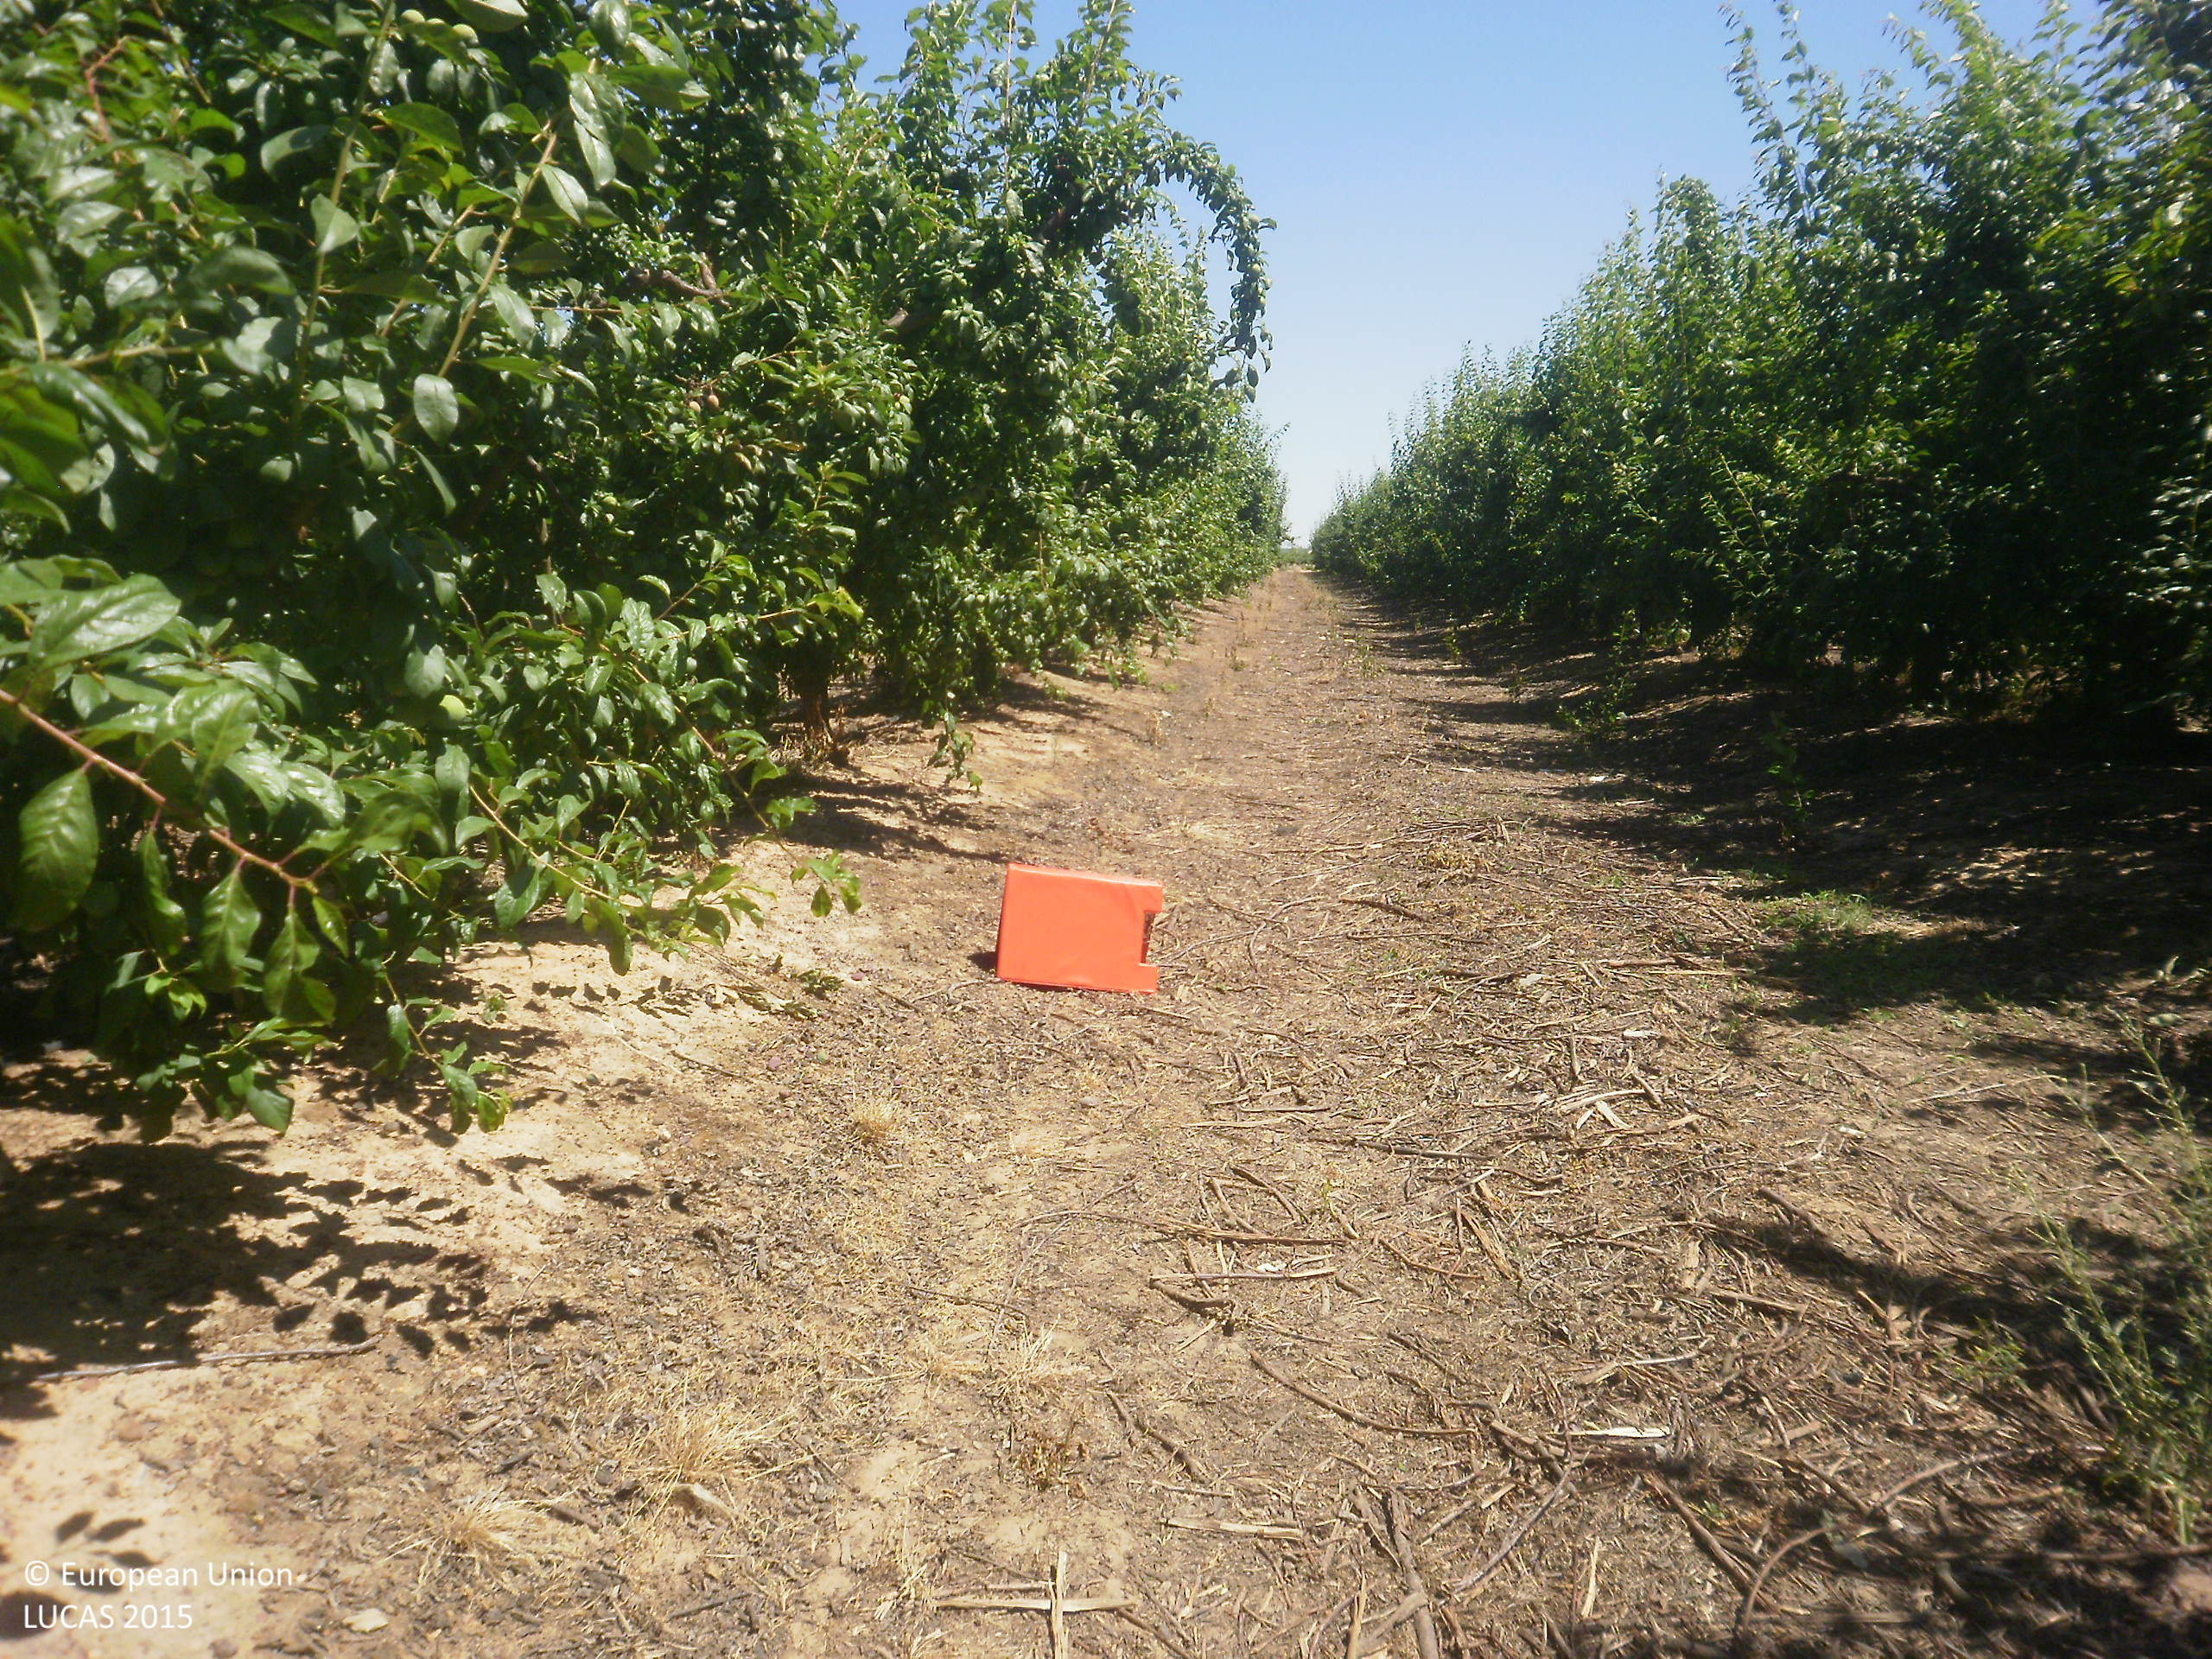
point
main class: Cropland
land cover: Other fruit trees and berries
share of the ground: 50 - 75 %
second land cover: Other bare soil
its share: > 75 %
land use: Agriculture (excluding fallow land and kitchen gardens)
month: May
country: ES
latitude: 39.0312
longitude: -5.7004
